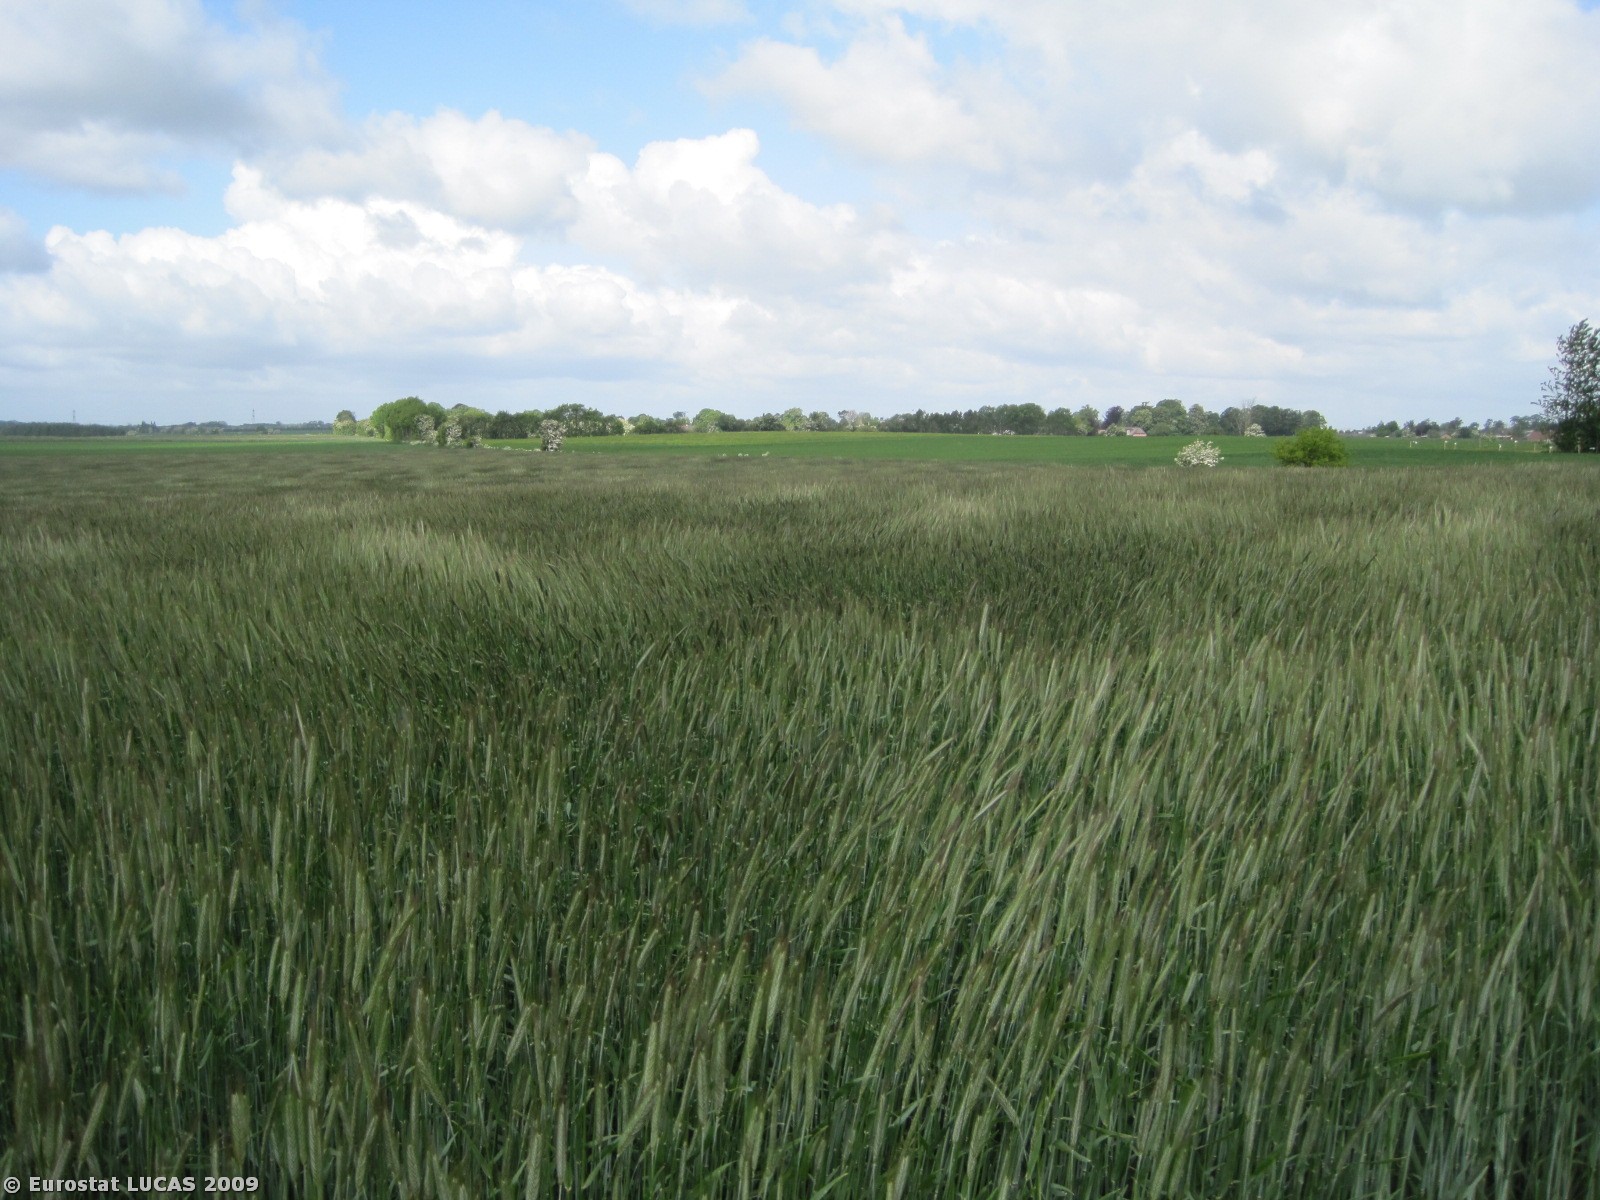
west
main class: Cropland
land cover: Common wheat
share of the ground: > 75 %
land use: Agriculture (excluding fallow land and kitchen gardens)
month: May
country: DK
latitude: 56.5473
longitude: 10.0162
